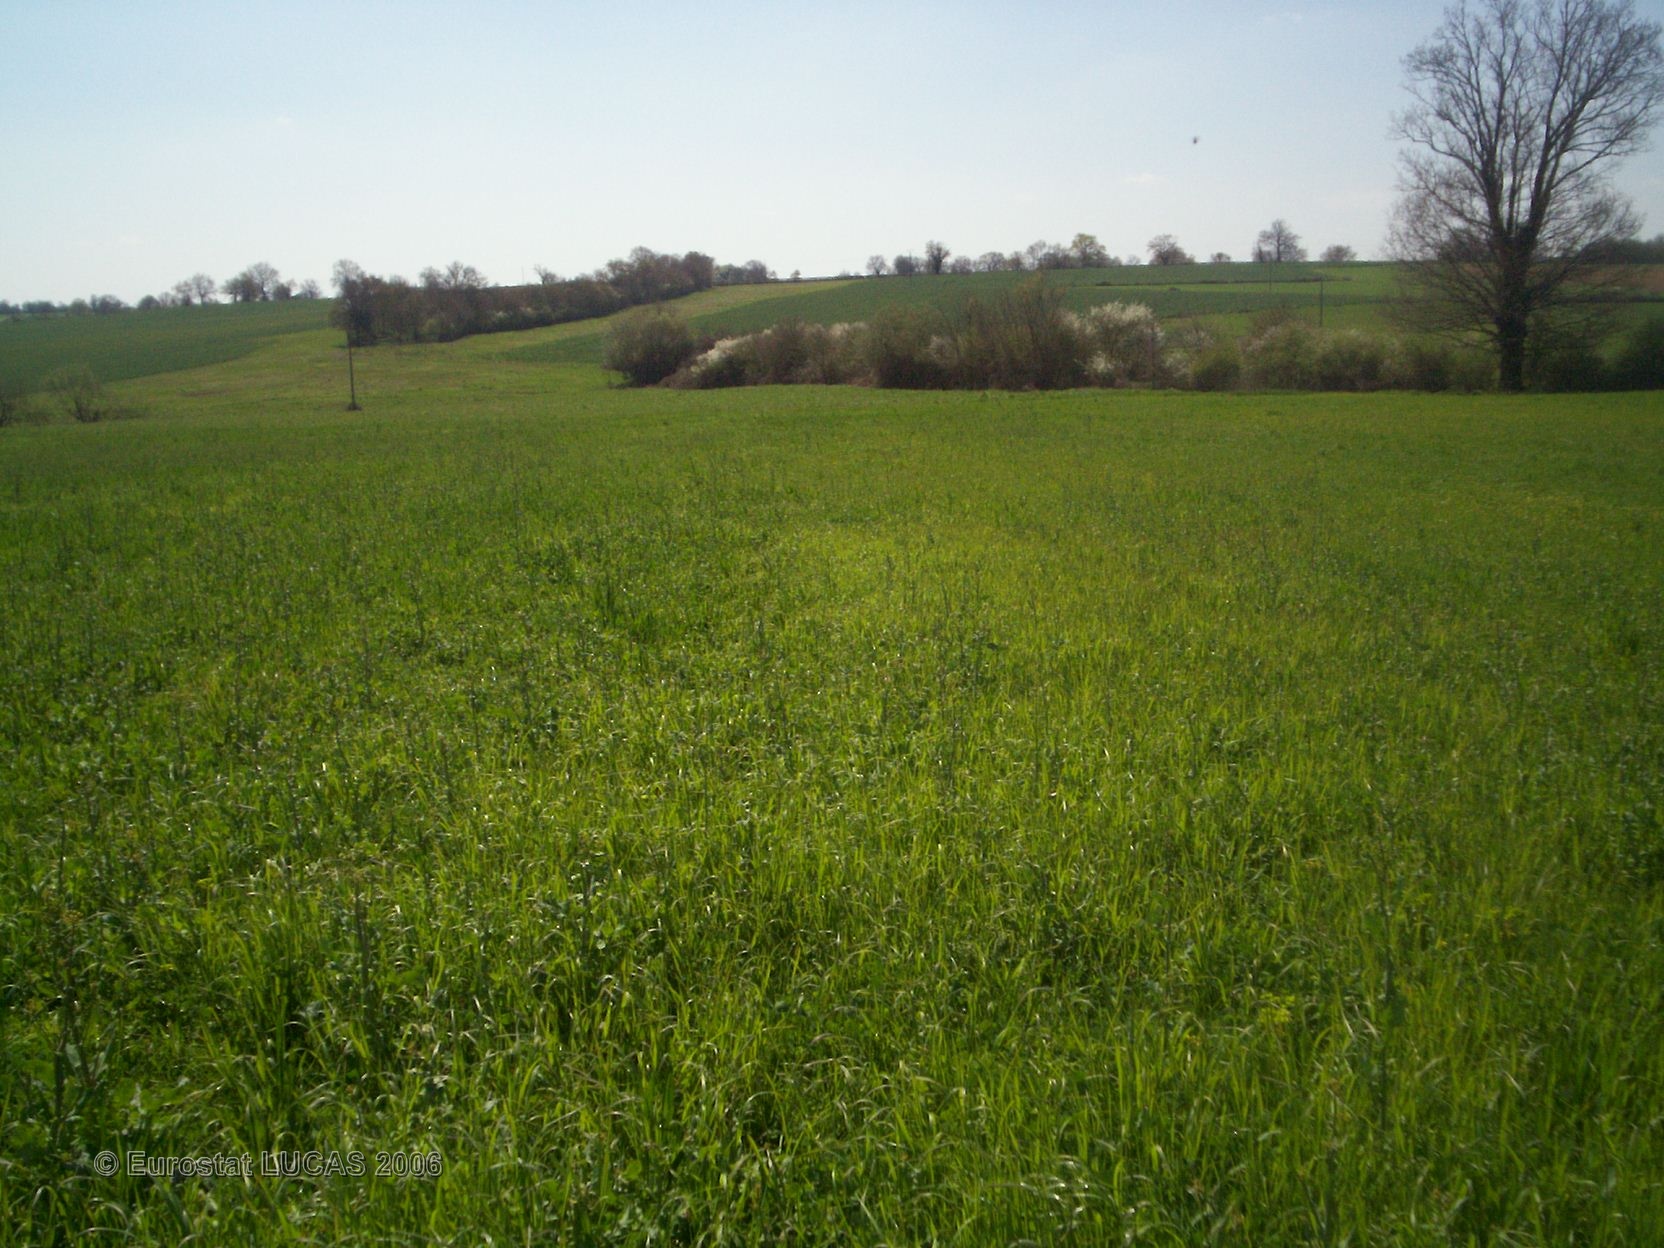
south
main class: Grassland
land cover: Grassland without tree/shrub cover
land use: Agriculture (excluding fallow land and kitchen gardens)
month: April
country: FR
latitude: 46.6318
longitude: 3.0611
